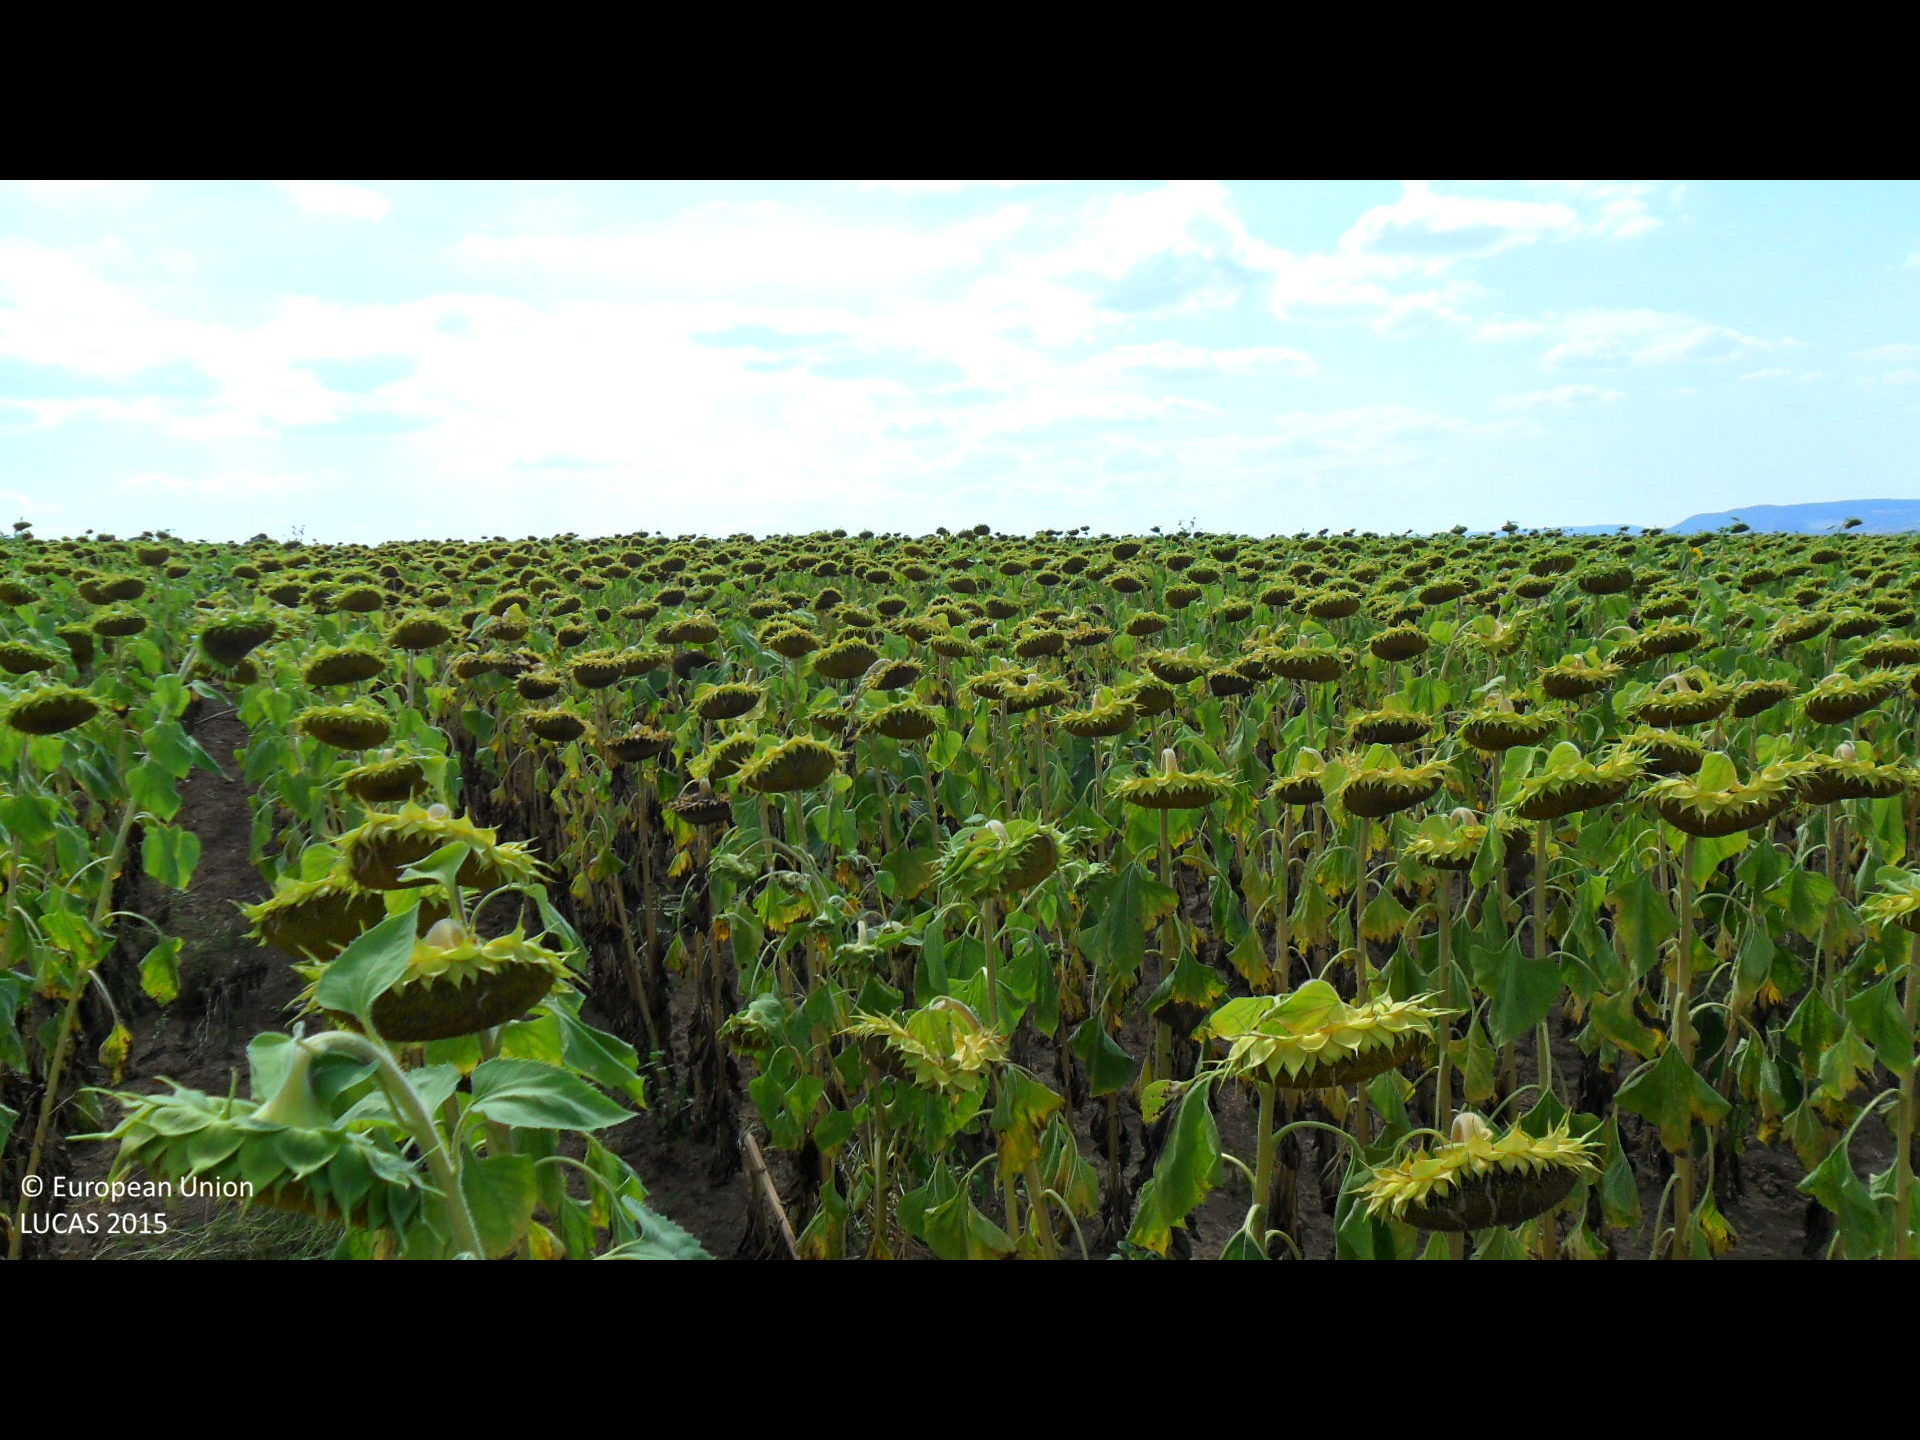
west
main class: Cropland
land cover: Sunflower
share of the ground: > 75 %
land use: Agriculture (excluding fallow land and kitchen gardens)
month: August
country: BG
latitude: 43.3908
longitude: 26.3586
